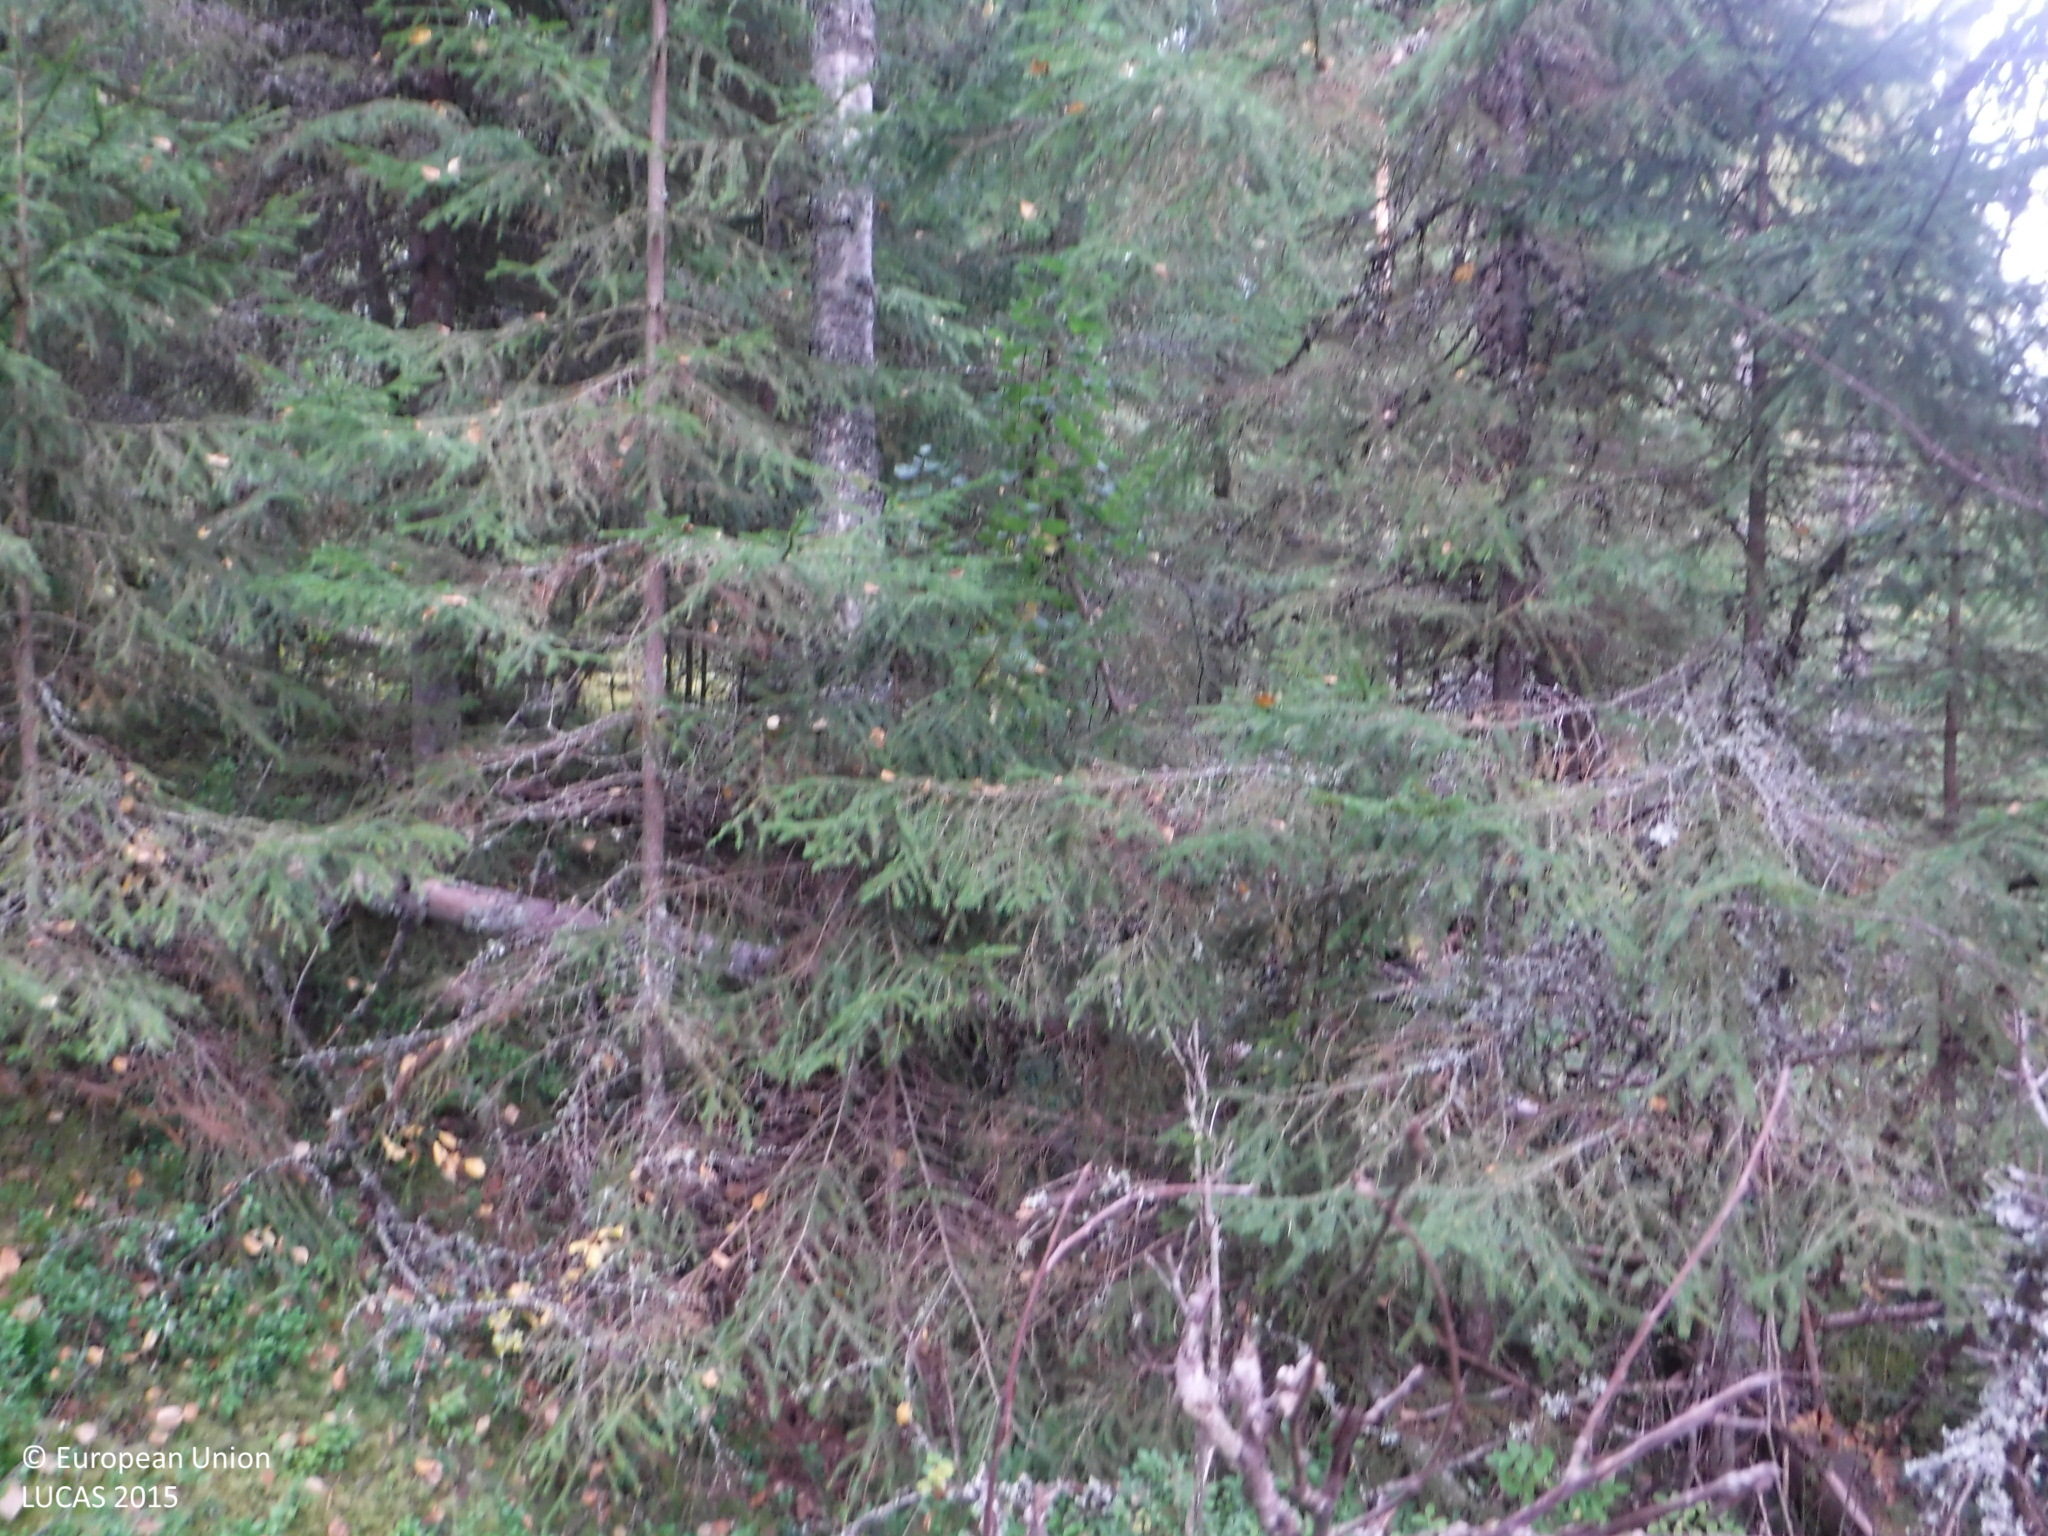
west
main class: Woodland
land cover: Spruce dominated mixed woodland
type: boreal forest
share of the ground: 50 - 75 %
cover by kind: coniferous forest trees 35 %, shrubs 25 %, lichens and mosses 25 %, broadleaved forest trees 15 %
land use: Forestry
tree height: > 5 m
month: September
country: FI
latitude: 61.7343
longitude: 22.1527
